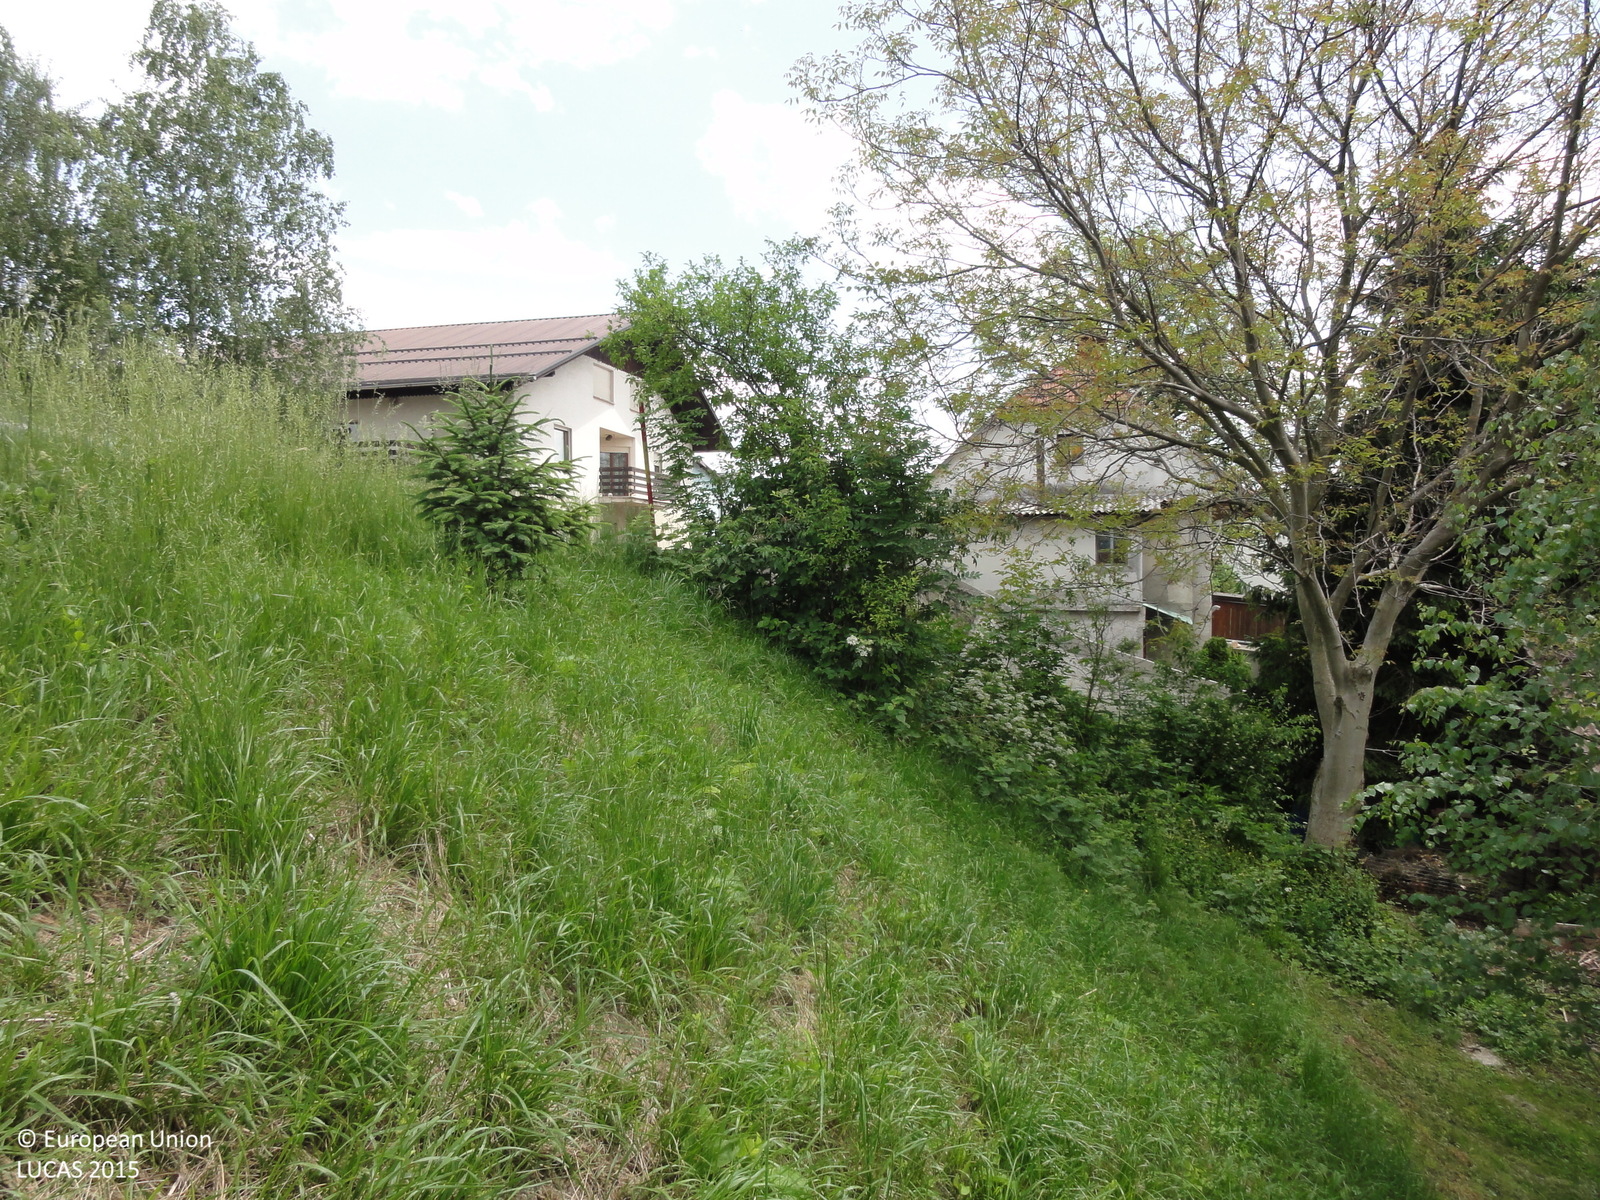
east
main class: Grassland
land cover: Grassland with sparse tree/shrub cover
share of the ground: > 75 %
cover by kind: herbaceous plants 90 %, broadleaved forest trees 5 %, shrubs 5 %
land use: Residential
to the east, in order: Grassland with sparse tree/shrub cover; Artificial constructions in urban areas; Grassland without tree/shrub cover; Other fruit trees and berries; Managed hedges; Grassland without tree/shrub cover; Sand; Railways; Grassland without tree/shrub cover; Tracks; Grass margins; Common wheat; Maize; Grass margins; Barley
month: May
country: SI
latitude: 46.2658
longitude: 15.0966
